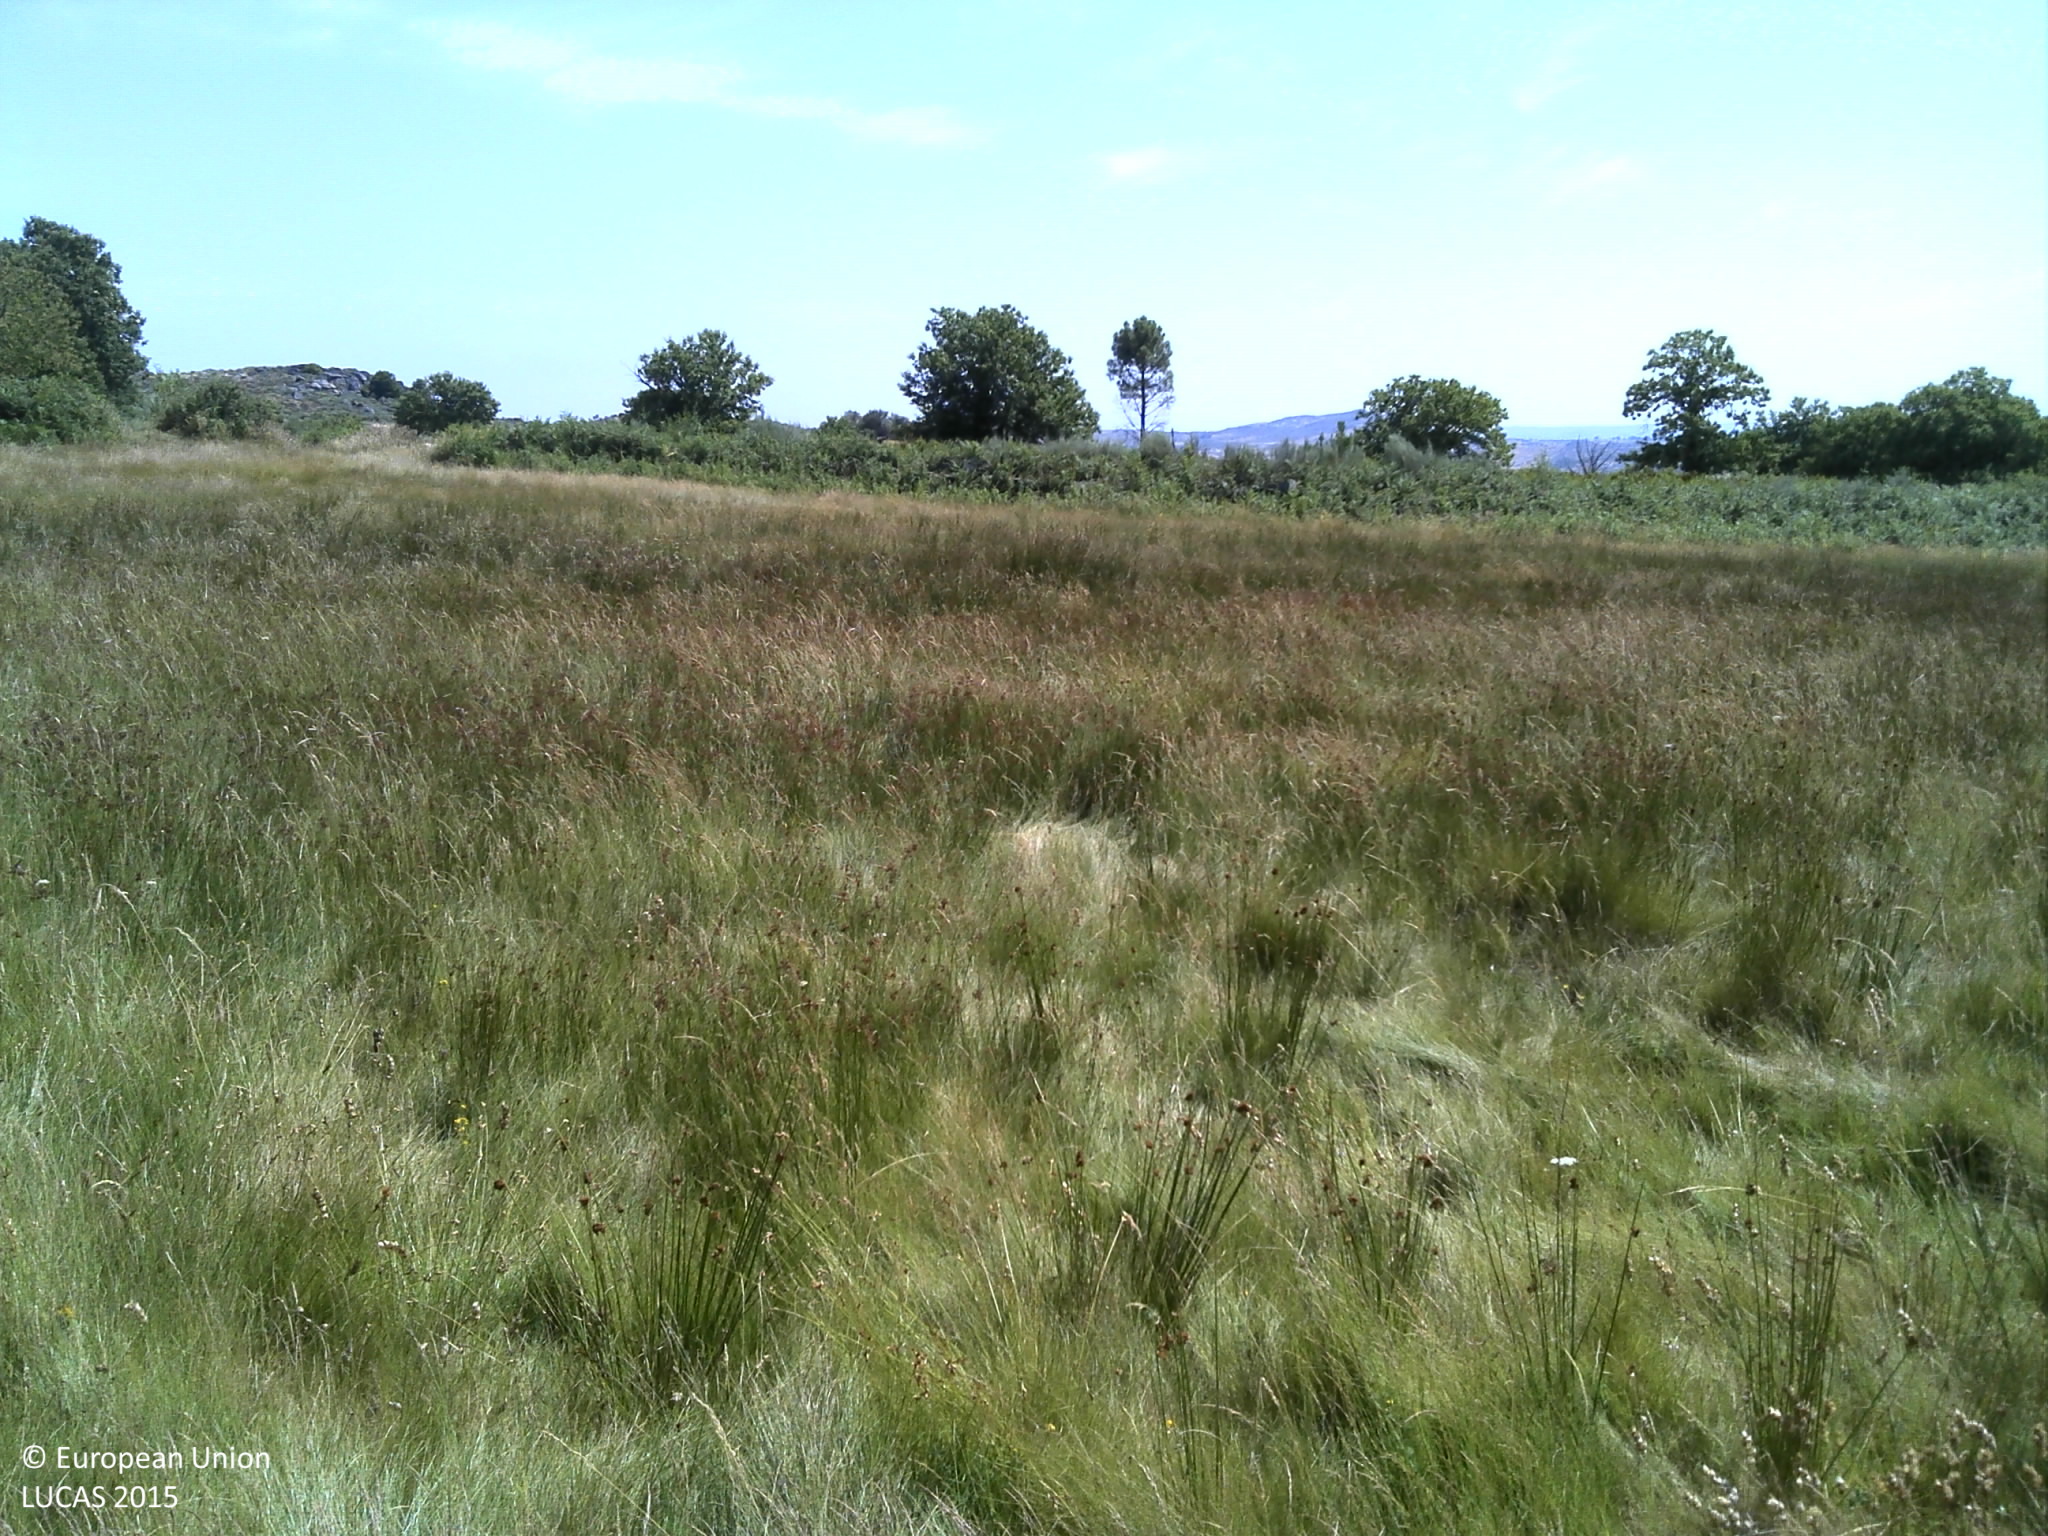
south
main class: Grassland
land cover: Grassland without tree/shrub cover
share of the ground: > 75 %
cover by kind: herbaceous plants 90 %, unconsolidated bare surface 10 %
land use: Agriculture (excluding fallow land and kitchen gardens)
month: July
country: PT
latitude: 41.0334
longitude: -7.4488
